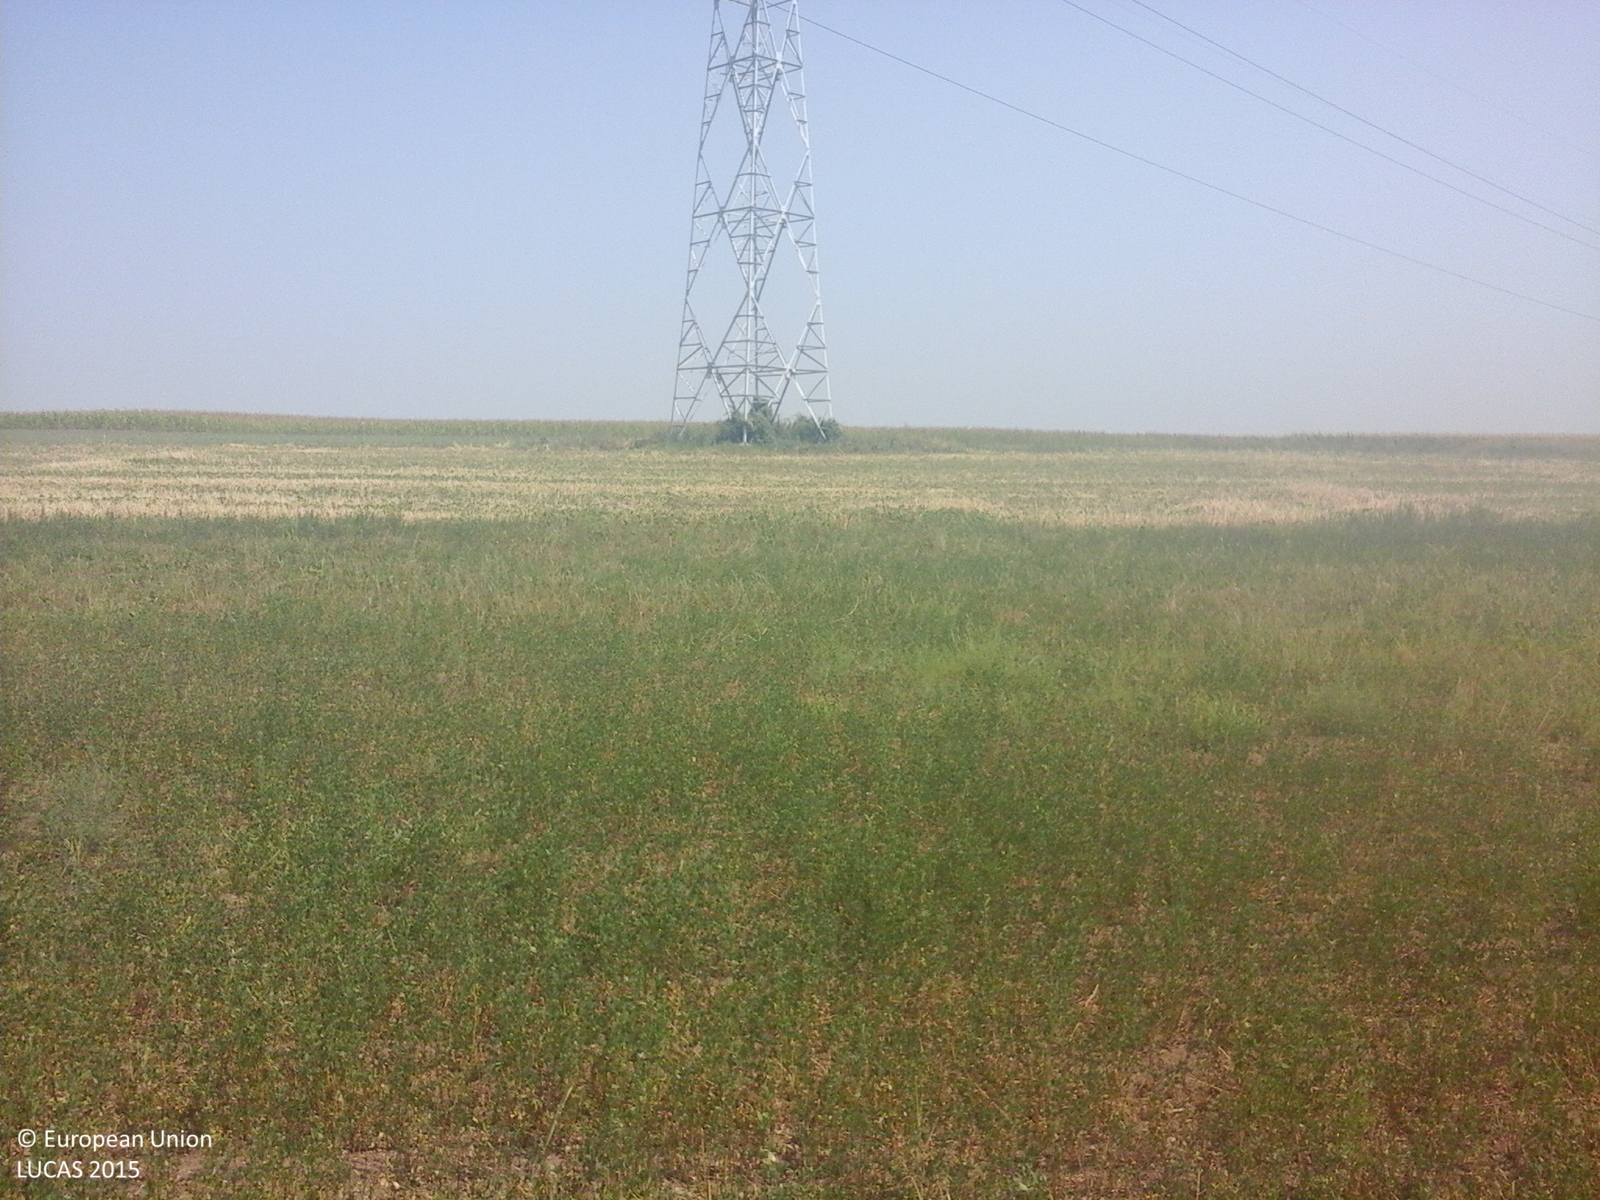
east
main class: Cropland
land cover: Lucerne
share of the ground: > 75 %
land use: Agriculture (excluding fallow land and kitchen gardens)
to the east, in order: Lucerne; Common wheat; Other bare soil; Electric lines; Other bare soil; Maize
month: July
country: RO
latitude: 45.4953
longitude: 27.8622
